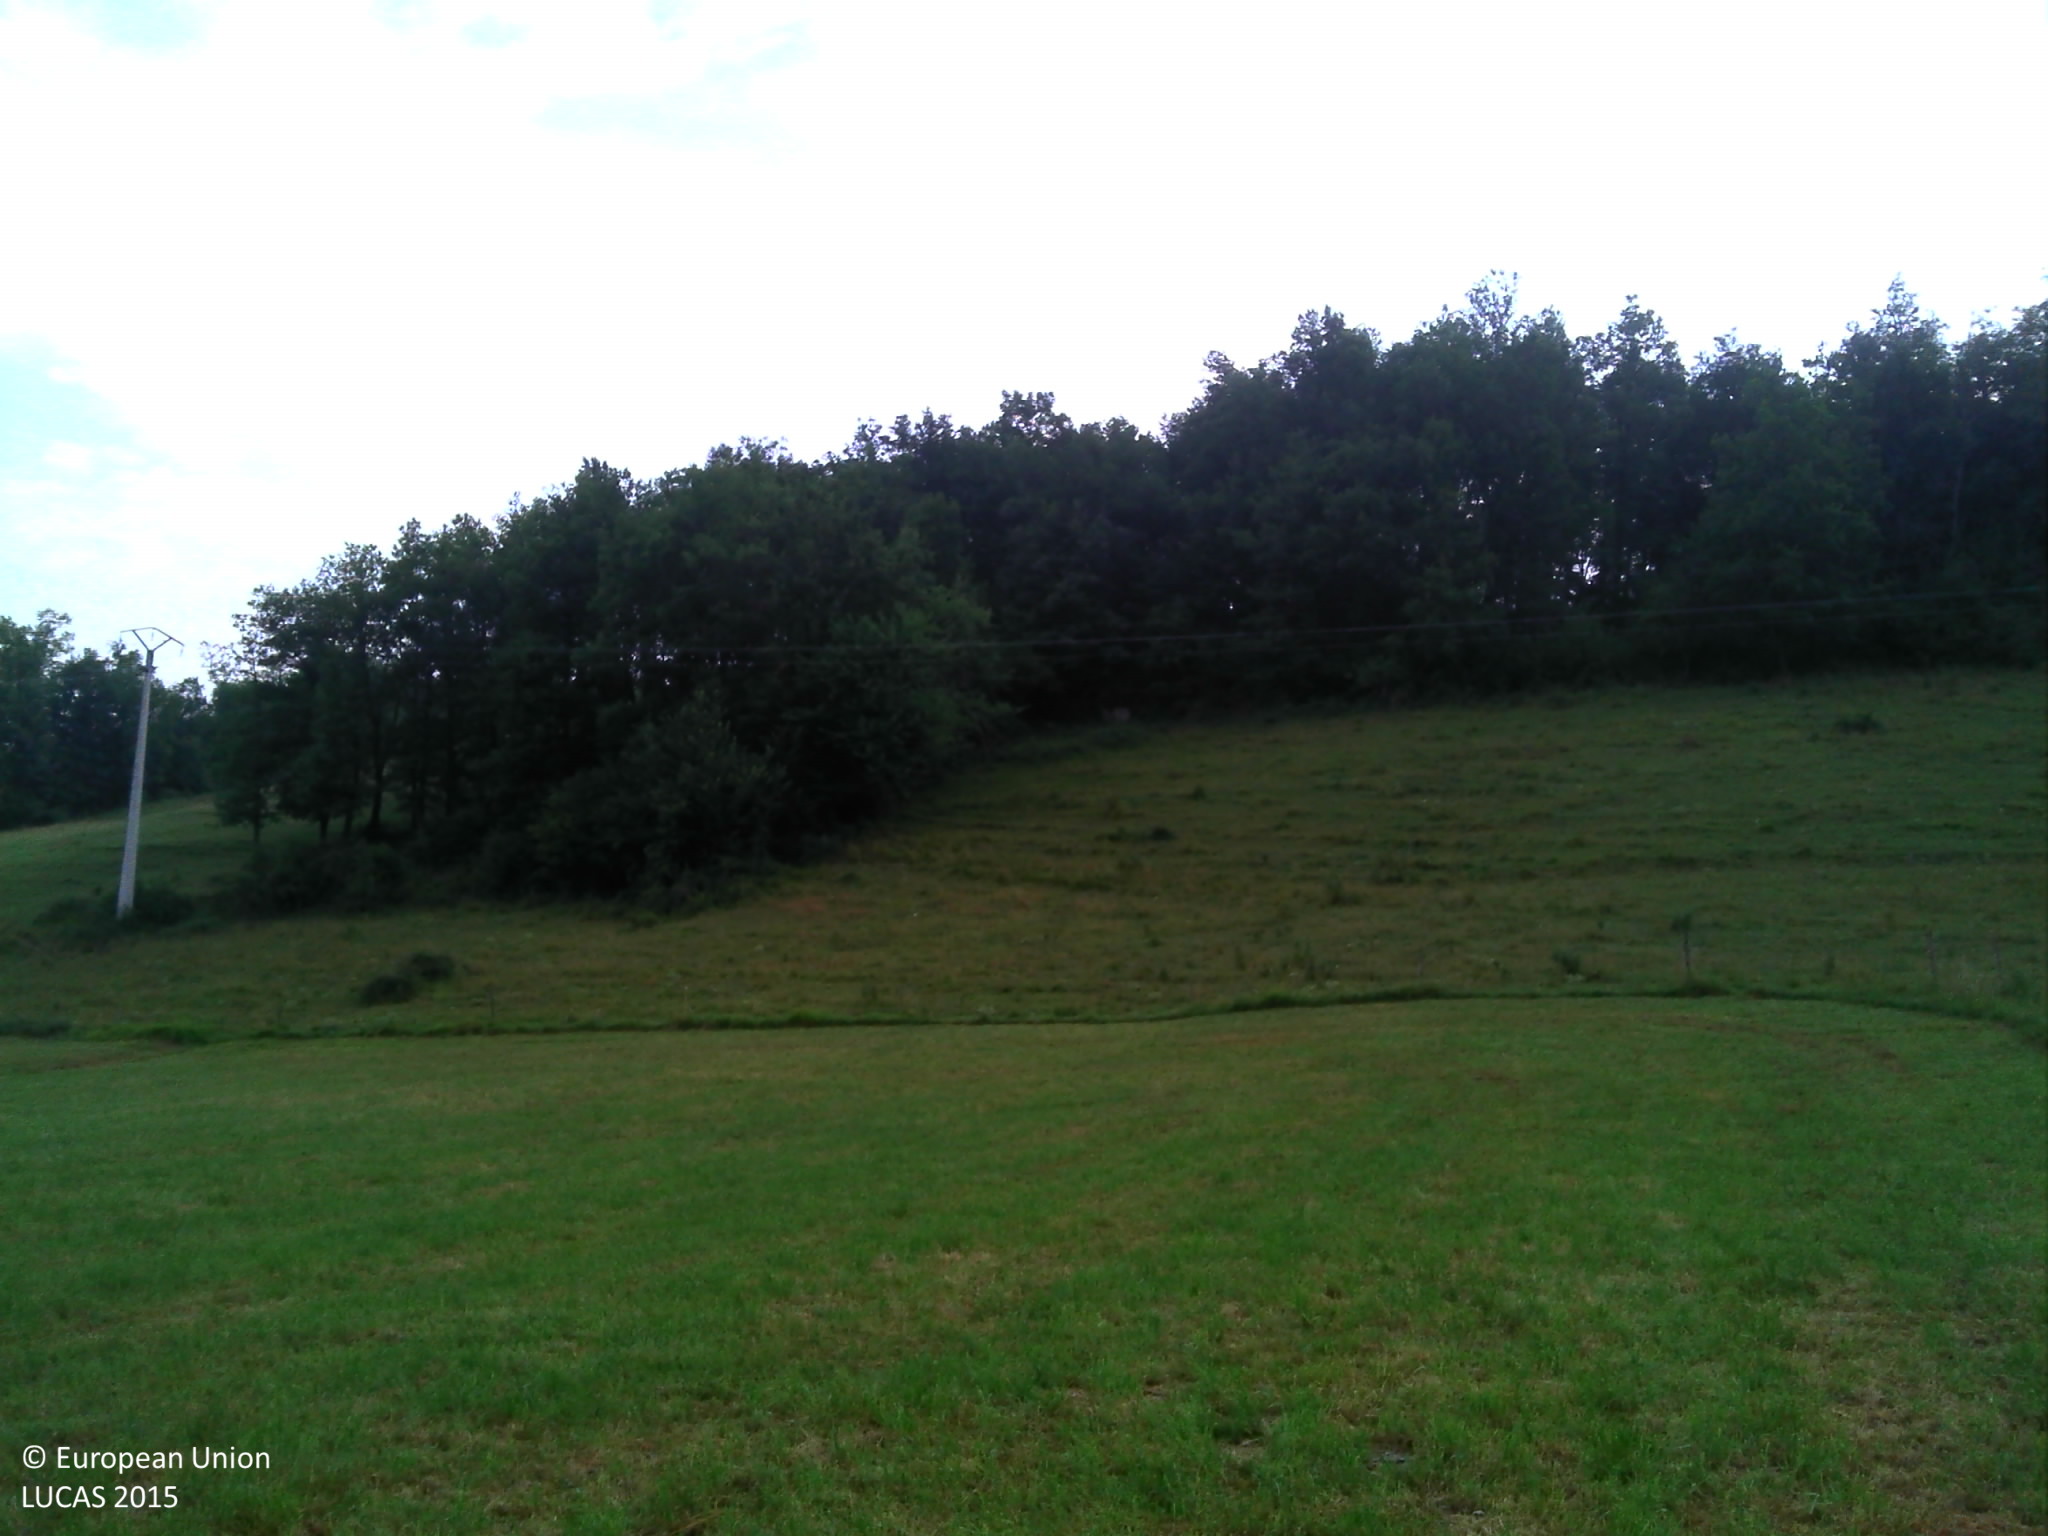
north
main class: Cropland
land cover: Temporary grasslands
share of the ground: > 75 %
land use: Agriculture (excluding fallow land and kitchen gardens)
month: July
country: FR
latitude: 43.0581
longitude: 1.4971
